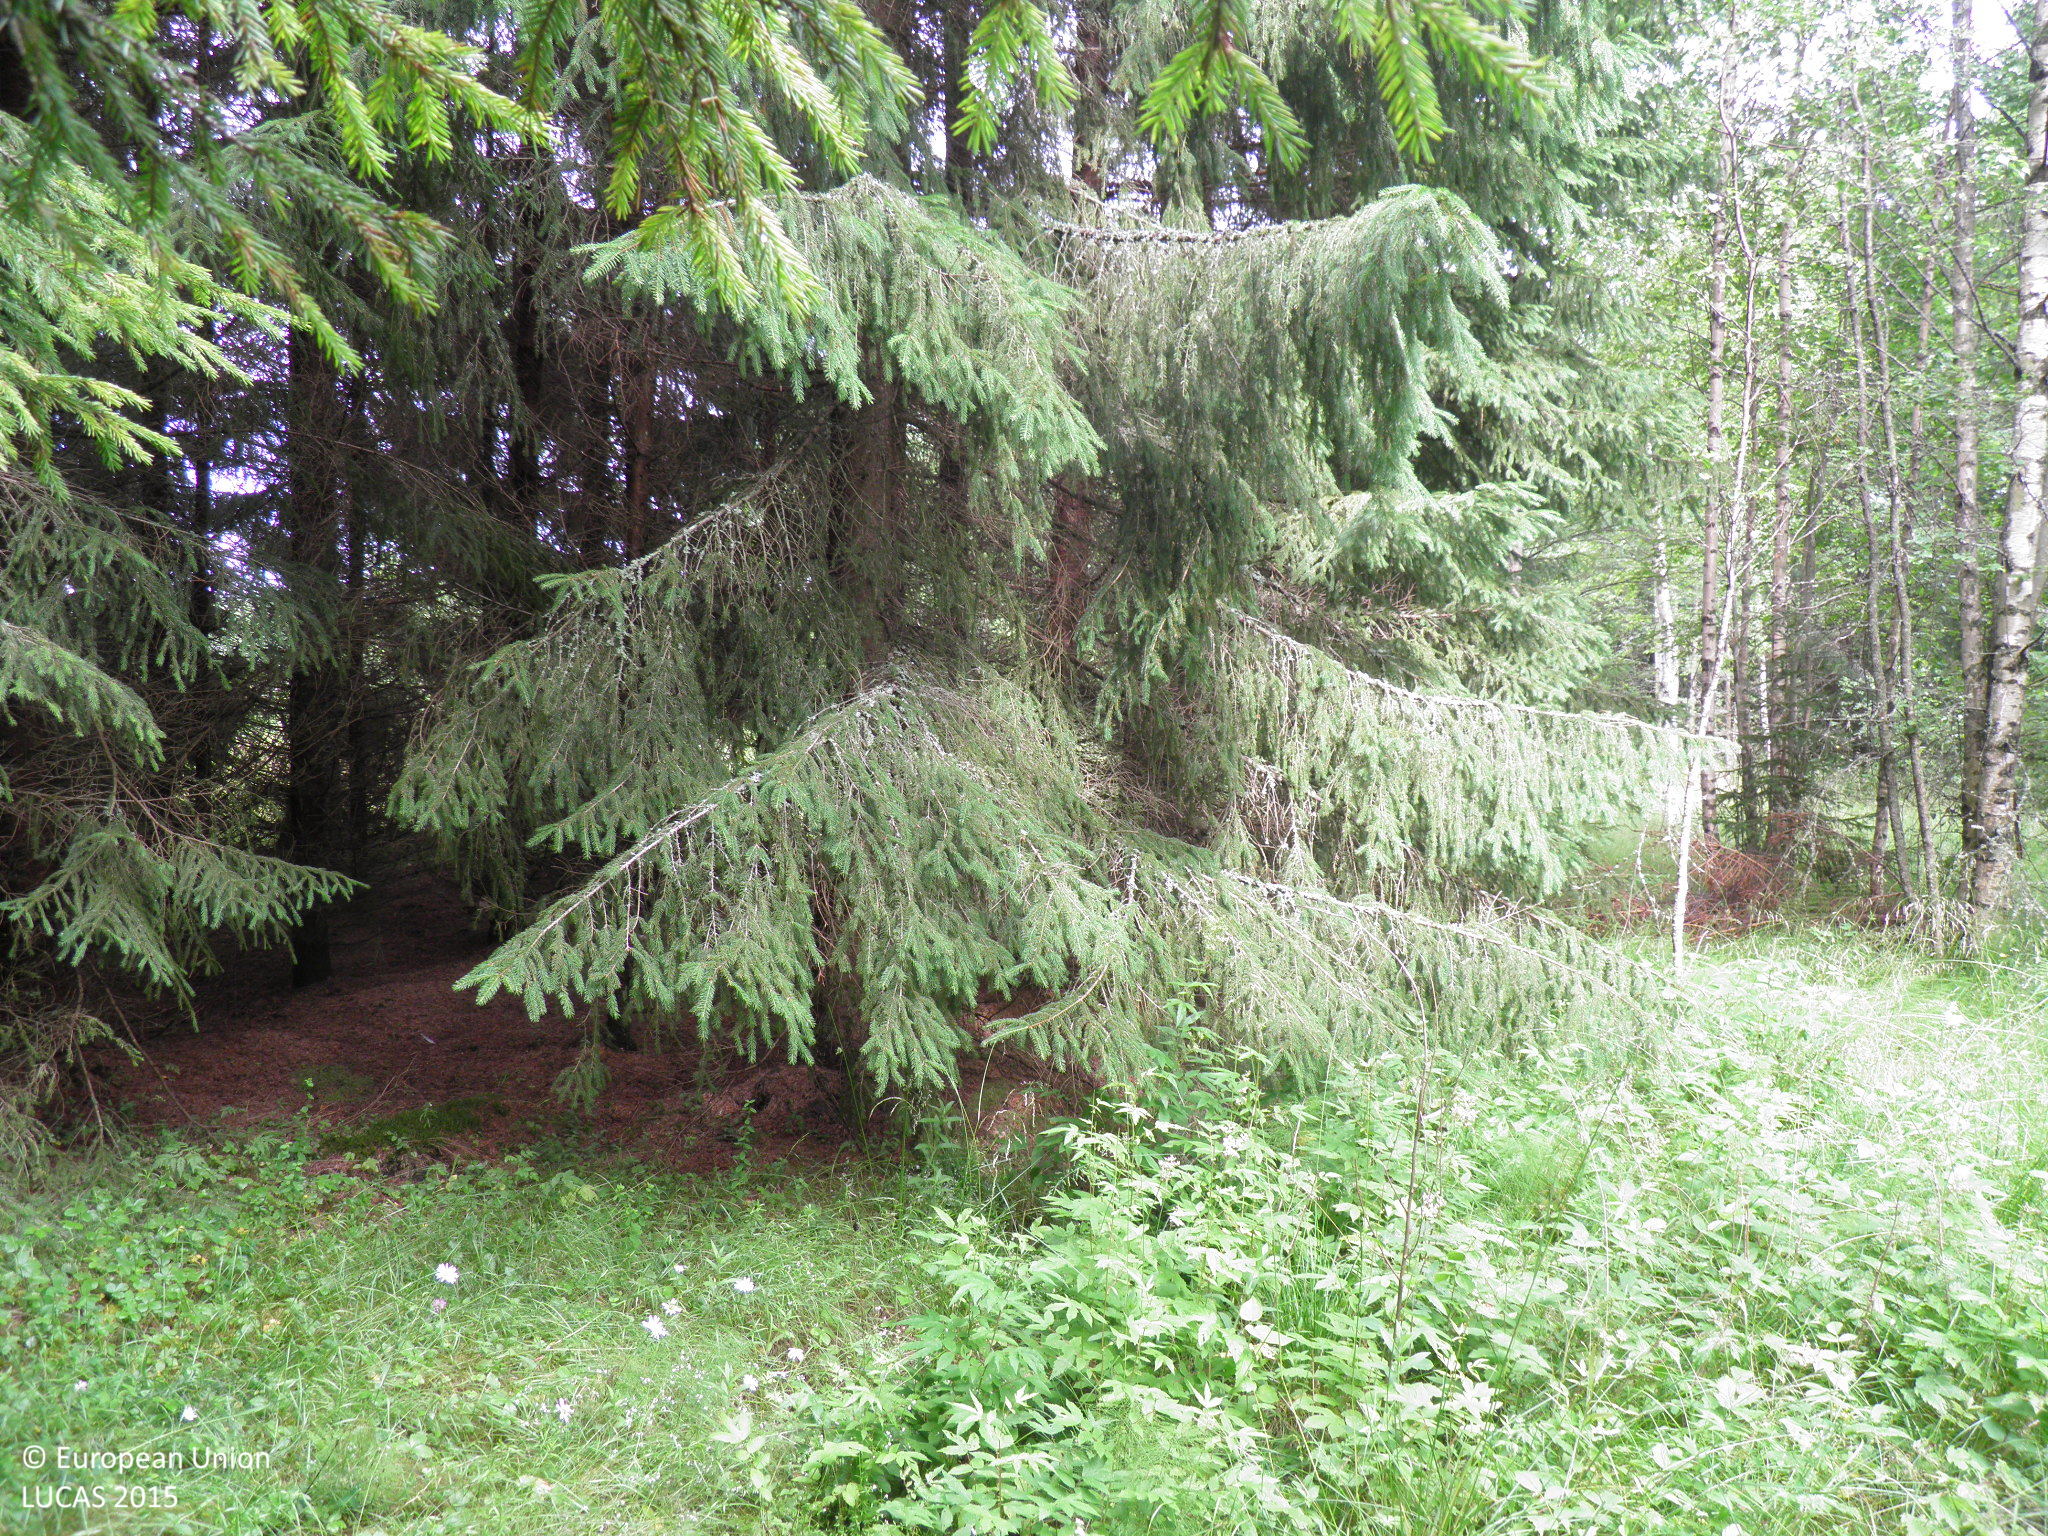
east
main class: Woodland
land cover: Spruce dominated coniferous woodland
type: boreal forest
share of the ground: > 75 %
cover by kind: coniferous forest trees 90 %, unconsolidated bare surface 10 %
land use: Forestry
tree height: > 5 m
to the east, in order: Spruce dominated coniferous woodland; Broadleaved woodland; Spruce dominated coniferous woodland; Electric lines; Spruce dominated coniferous woodland; Ditches and canals; Grass margins; Tracks; Grass margins; Ditches and canals; Abandoned hedges; Dry pulses
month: July
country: FI
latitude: 60.0696
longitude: 22.5981
